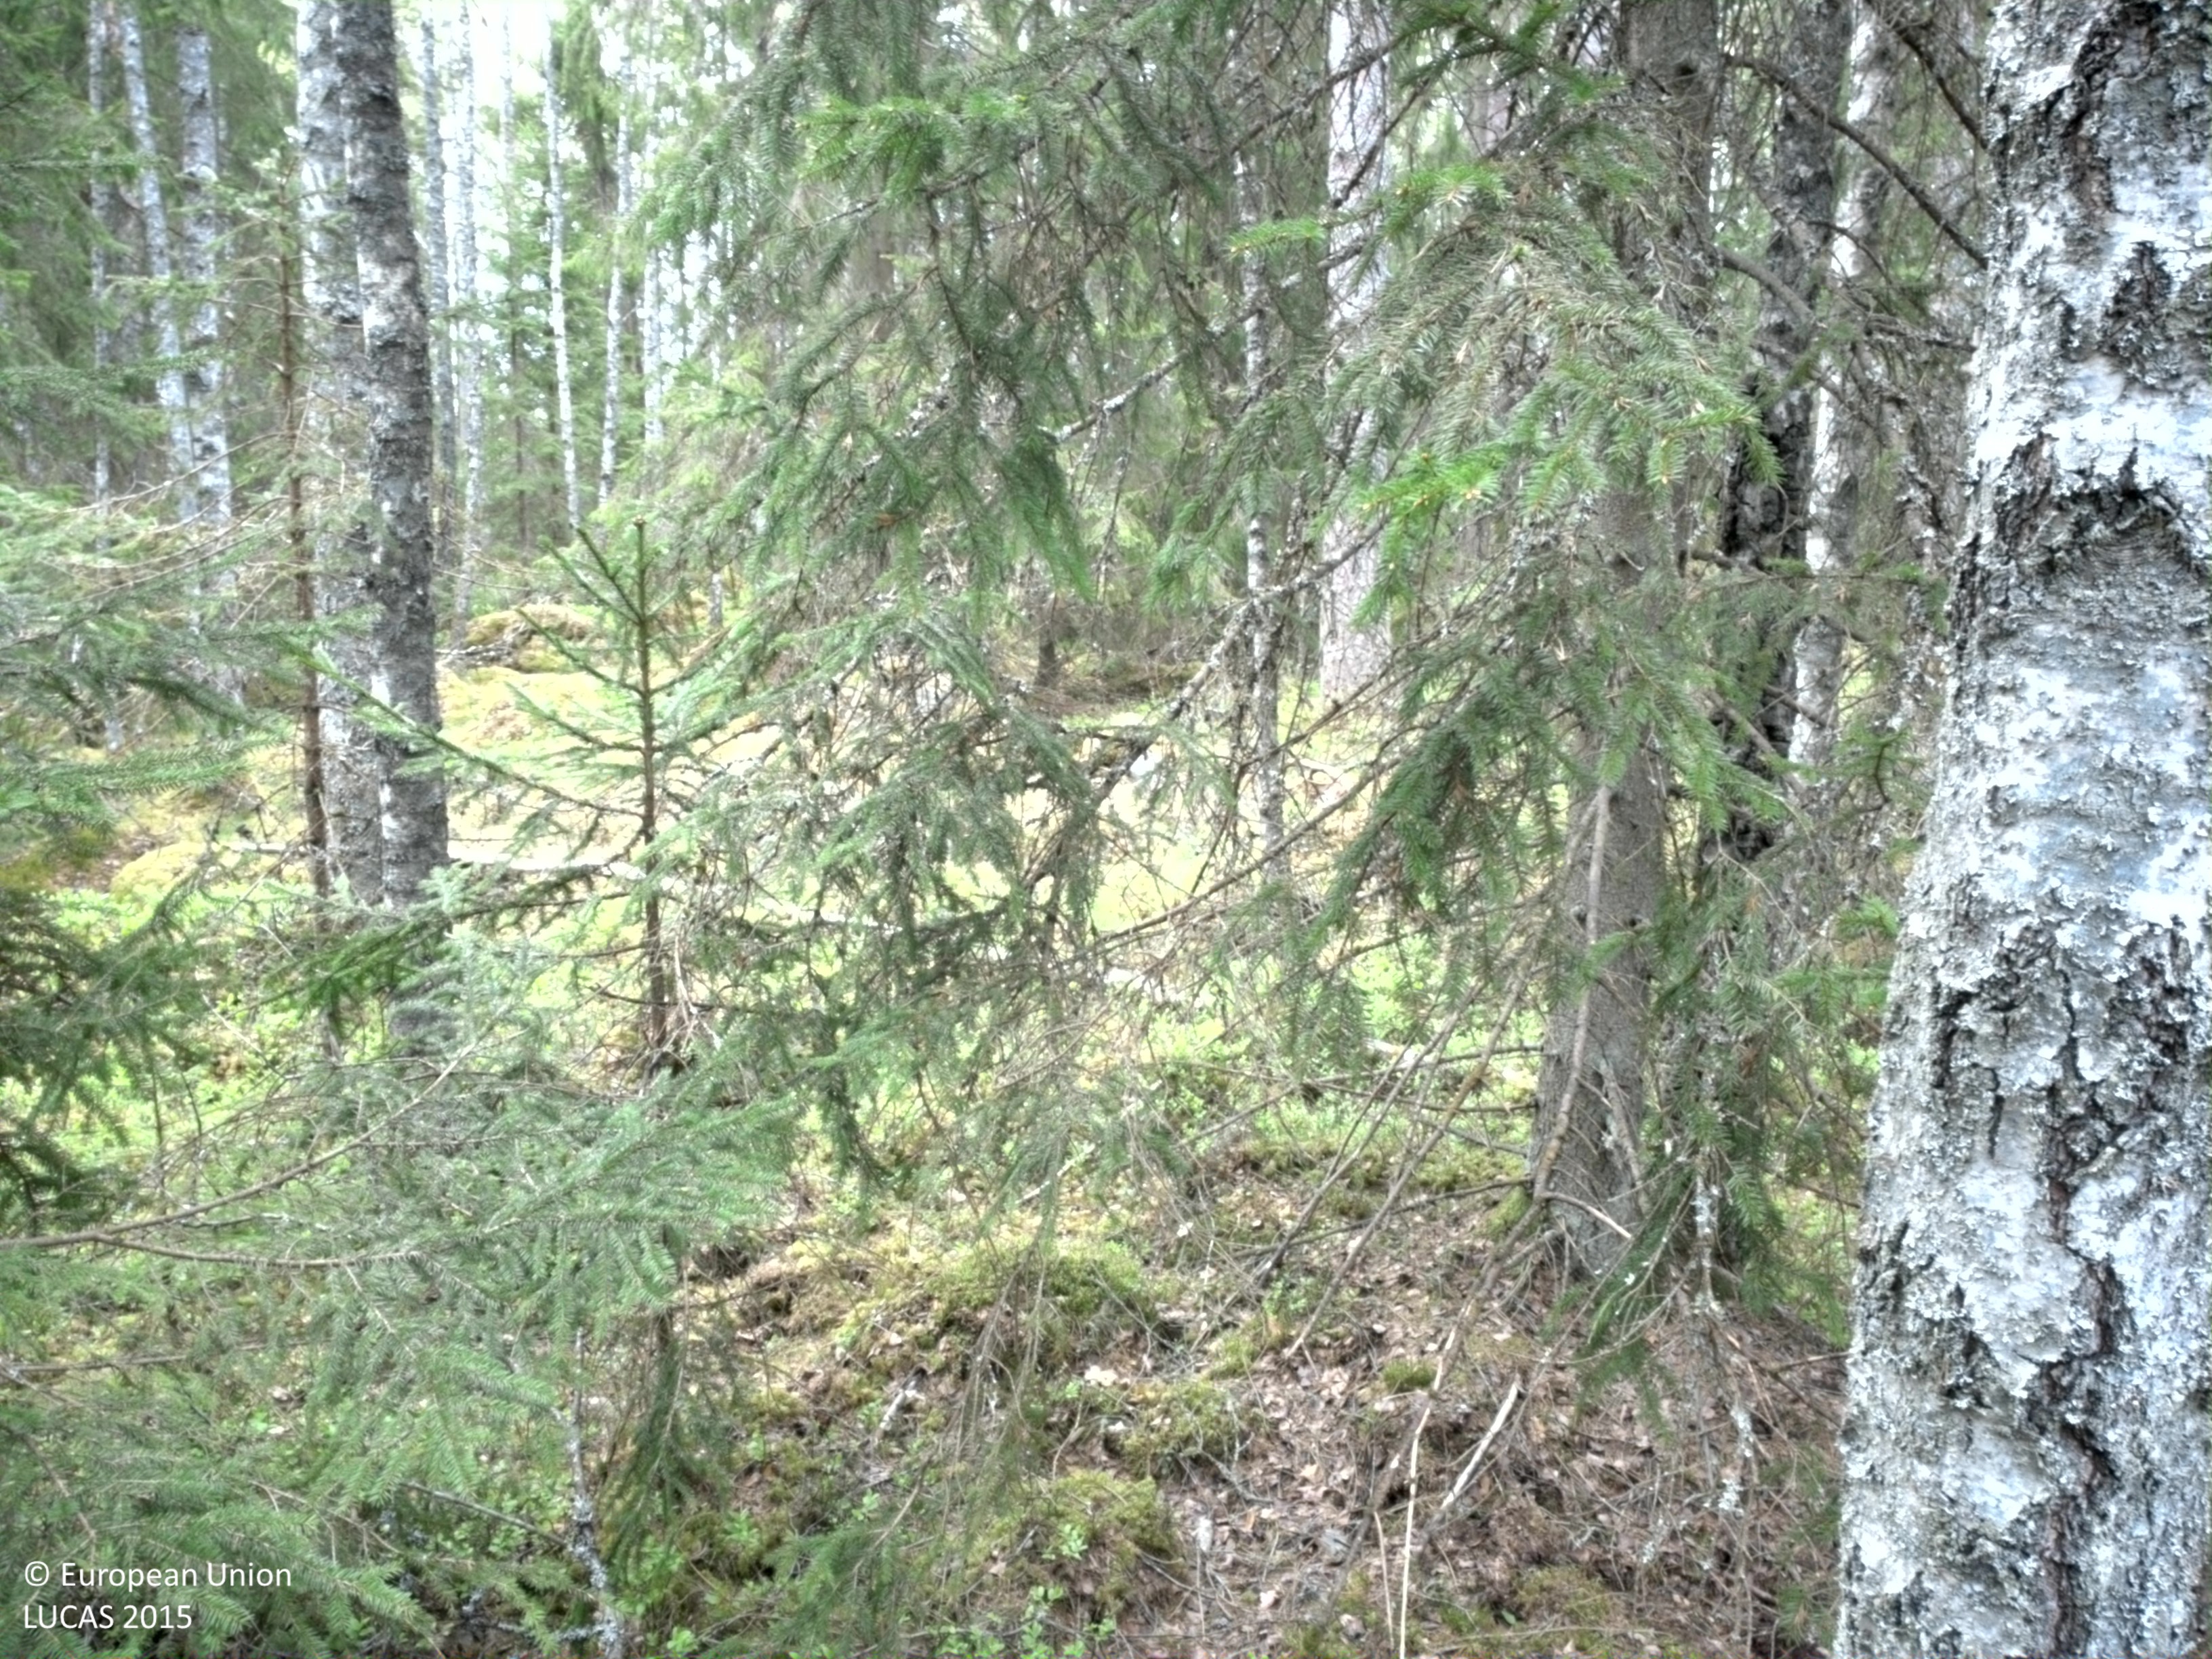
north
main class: Woodland
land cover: Spruce dominated mixed woodland
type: boreal forest
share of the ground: 50 - 75 %
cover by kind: coniferous forest trees 50 %, broadleaved forest trees 25 %, shrubs 15 %, lichens and mosses 10 %
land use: Forestry
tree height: > 5 m
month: May
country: SE
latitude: 56.7034
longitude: 15.4373
